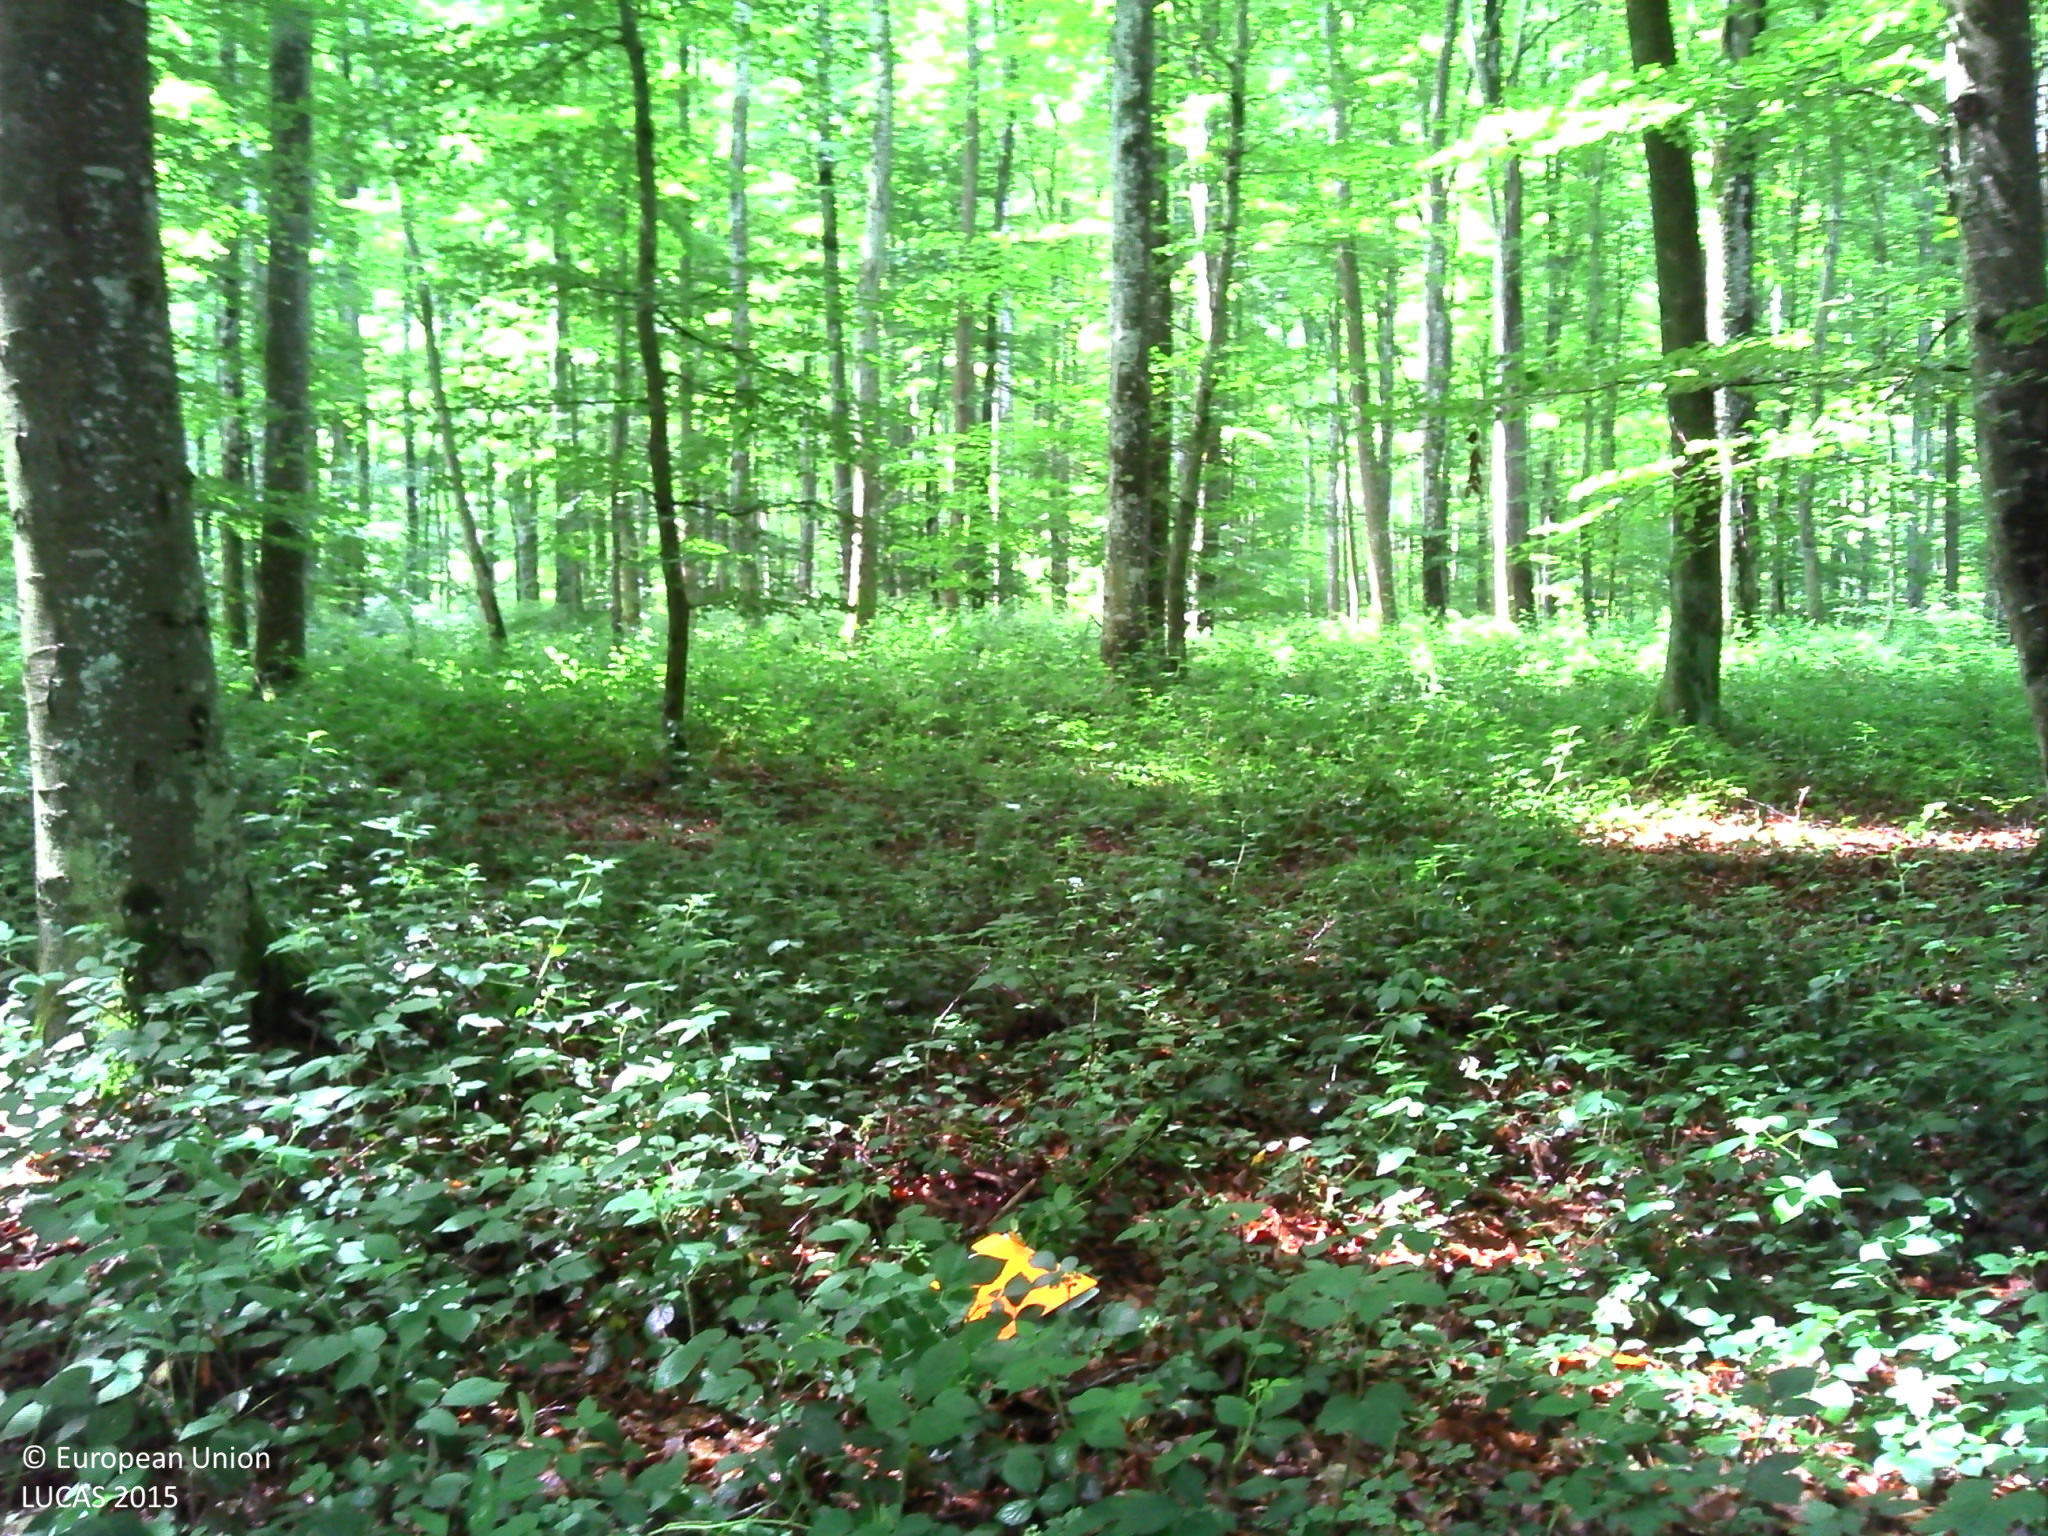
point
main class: Woodland
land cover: Broadleaved woodland
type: beech forest
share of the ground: > 75 %
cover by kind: broadleaved forest trees 90 %, shrubs 5 %, herbaceous plants 5 %
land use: Forestry
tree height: > 5 m
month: June
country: FR
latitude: 46.2129
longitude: 3.0114
